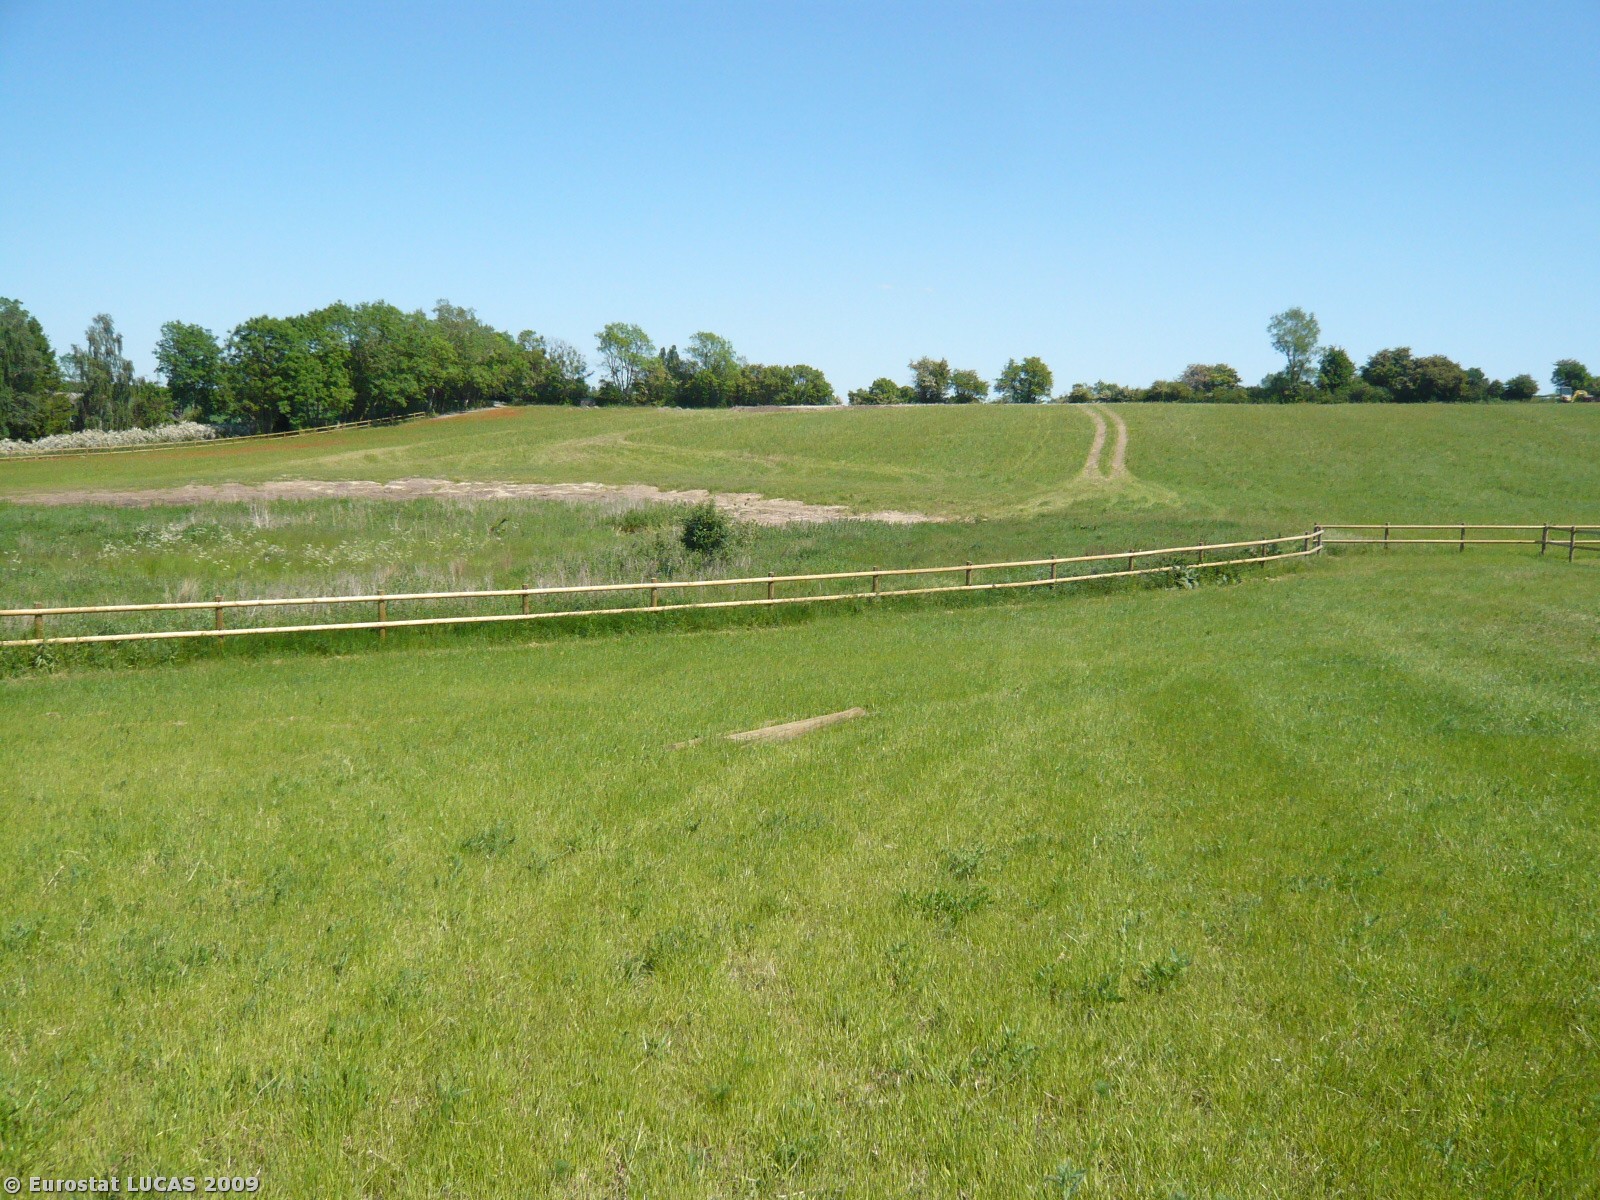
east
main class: Grassland
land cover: Grassland without tree/shrub cover
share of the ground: > 75 %
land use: Agriculture (excluding fallow land and kitchen gardens)
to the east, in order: Grassland without tree/shrub cover; Fences; Grassland without tree/shrub cover; Bare land; Grassland without tree/shrub cover; Tracks; Bare land; Grassland without tree/shrub cover; Tracks; Broadleaved woodland; Spontaneously vegetated surfaces; Inland marshes
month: June
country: DK
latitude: 55.6505
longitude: 12.0165
